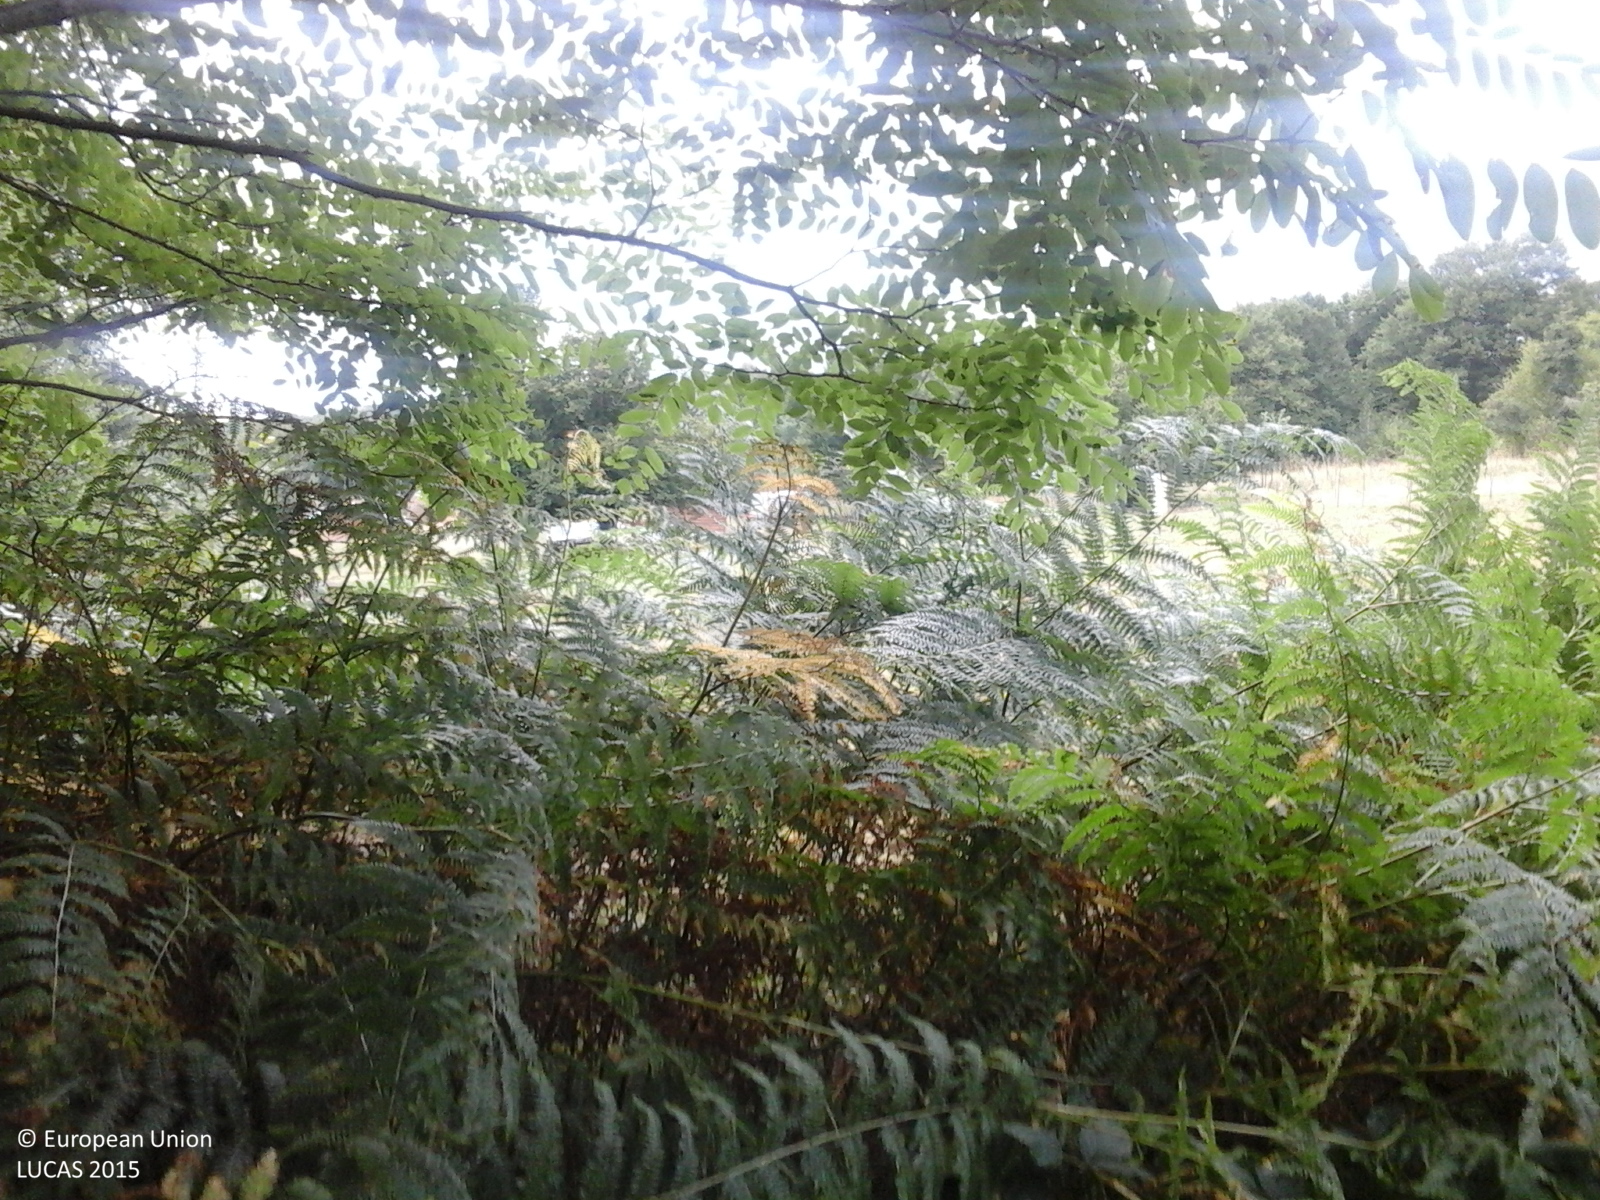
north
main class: Woodland
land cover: Broadleaved woodland
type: broadleaved evergreen forest
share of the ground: > 75 %
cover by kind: broadleaved forest trees 100 %
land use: Forestry
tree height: > 5 m
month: August
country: RO
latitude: 45.2065
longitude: 21.9400
